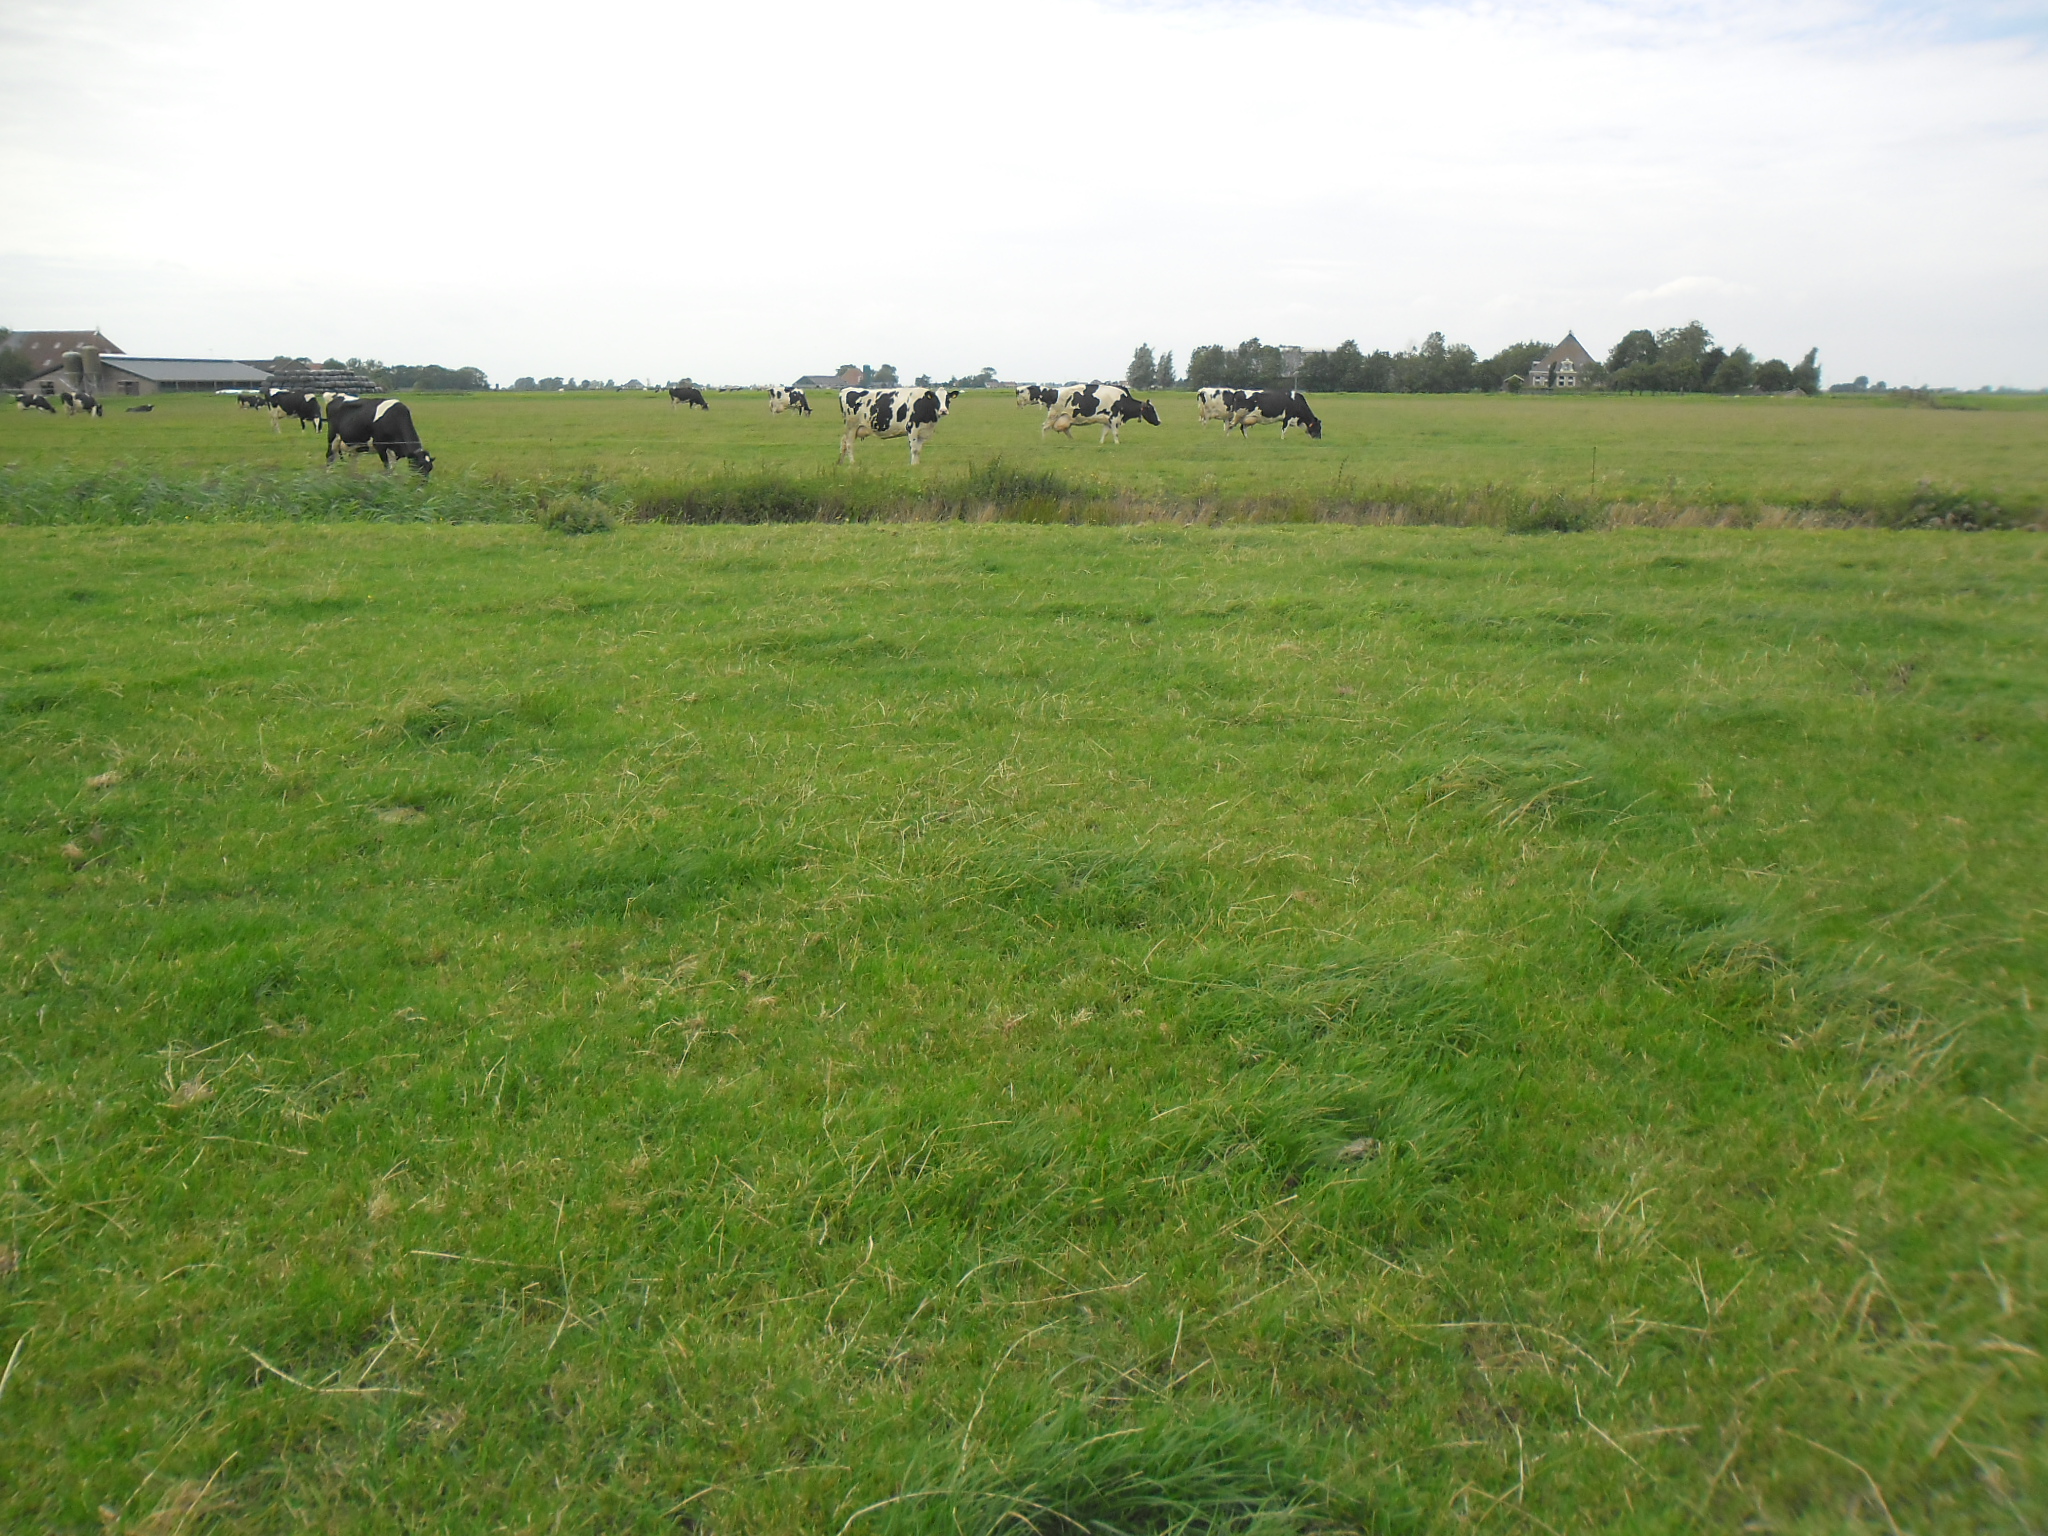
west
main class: Grassland
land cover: Grassland without tree/shrub cover
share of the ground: > 75 %
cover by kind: herbaceous plants 100 %
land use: Agriculture (excluding fallow land and kitchen gardens)
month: August
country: NL
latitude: 53.0150
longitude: 5.5718
